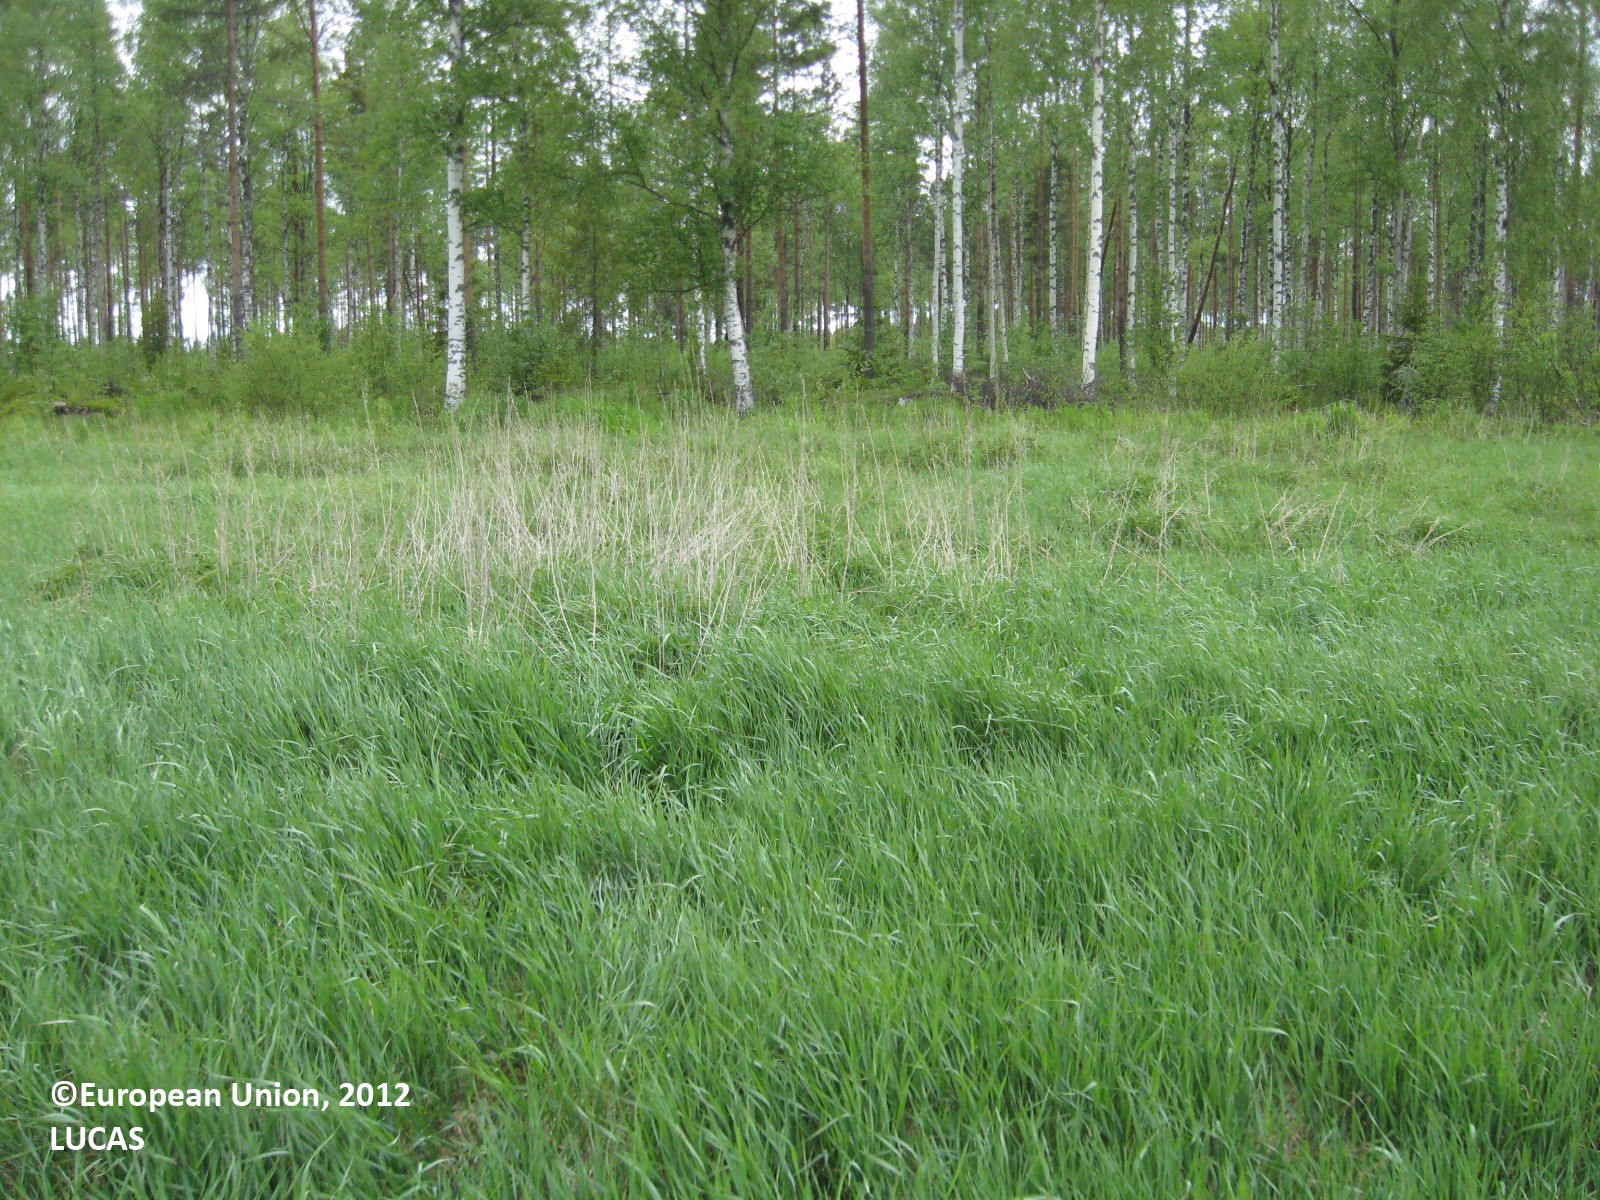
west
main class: Cropland
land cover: Other cereals
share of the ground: < 10 %
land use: Agriculture (excluding fallow land and kitchen gardens)
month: May
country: FI
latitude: 61.8311
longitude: 22.3060
